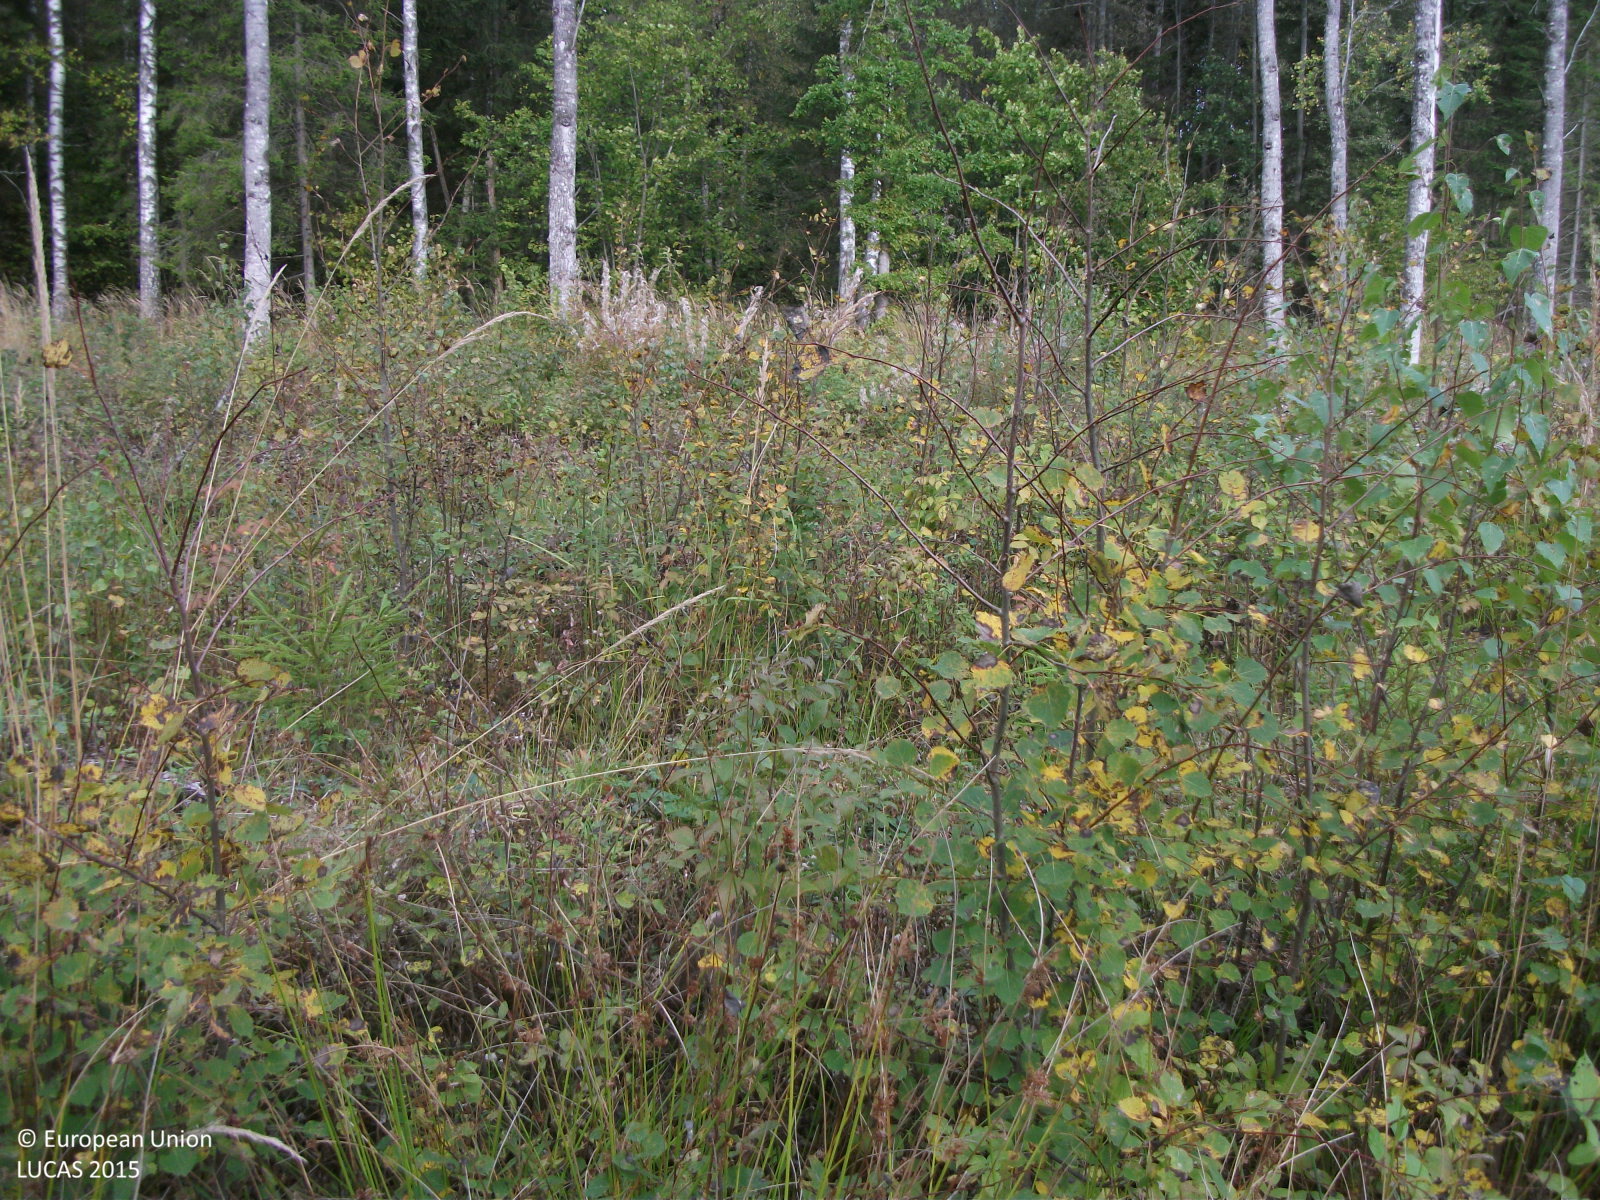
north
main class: Grassland
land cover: Grassland with sparse tree/shrub cover
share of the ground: > 75 %
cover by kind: herbaceous plants 90 %, coniferous forest trees 5 %, shrubs 5 %
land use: Forestry
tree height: < 5 m
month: September
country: LV
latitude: 57.6519
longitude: 24.6211
